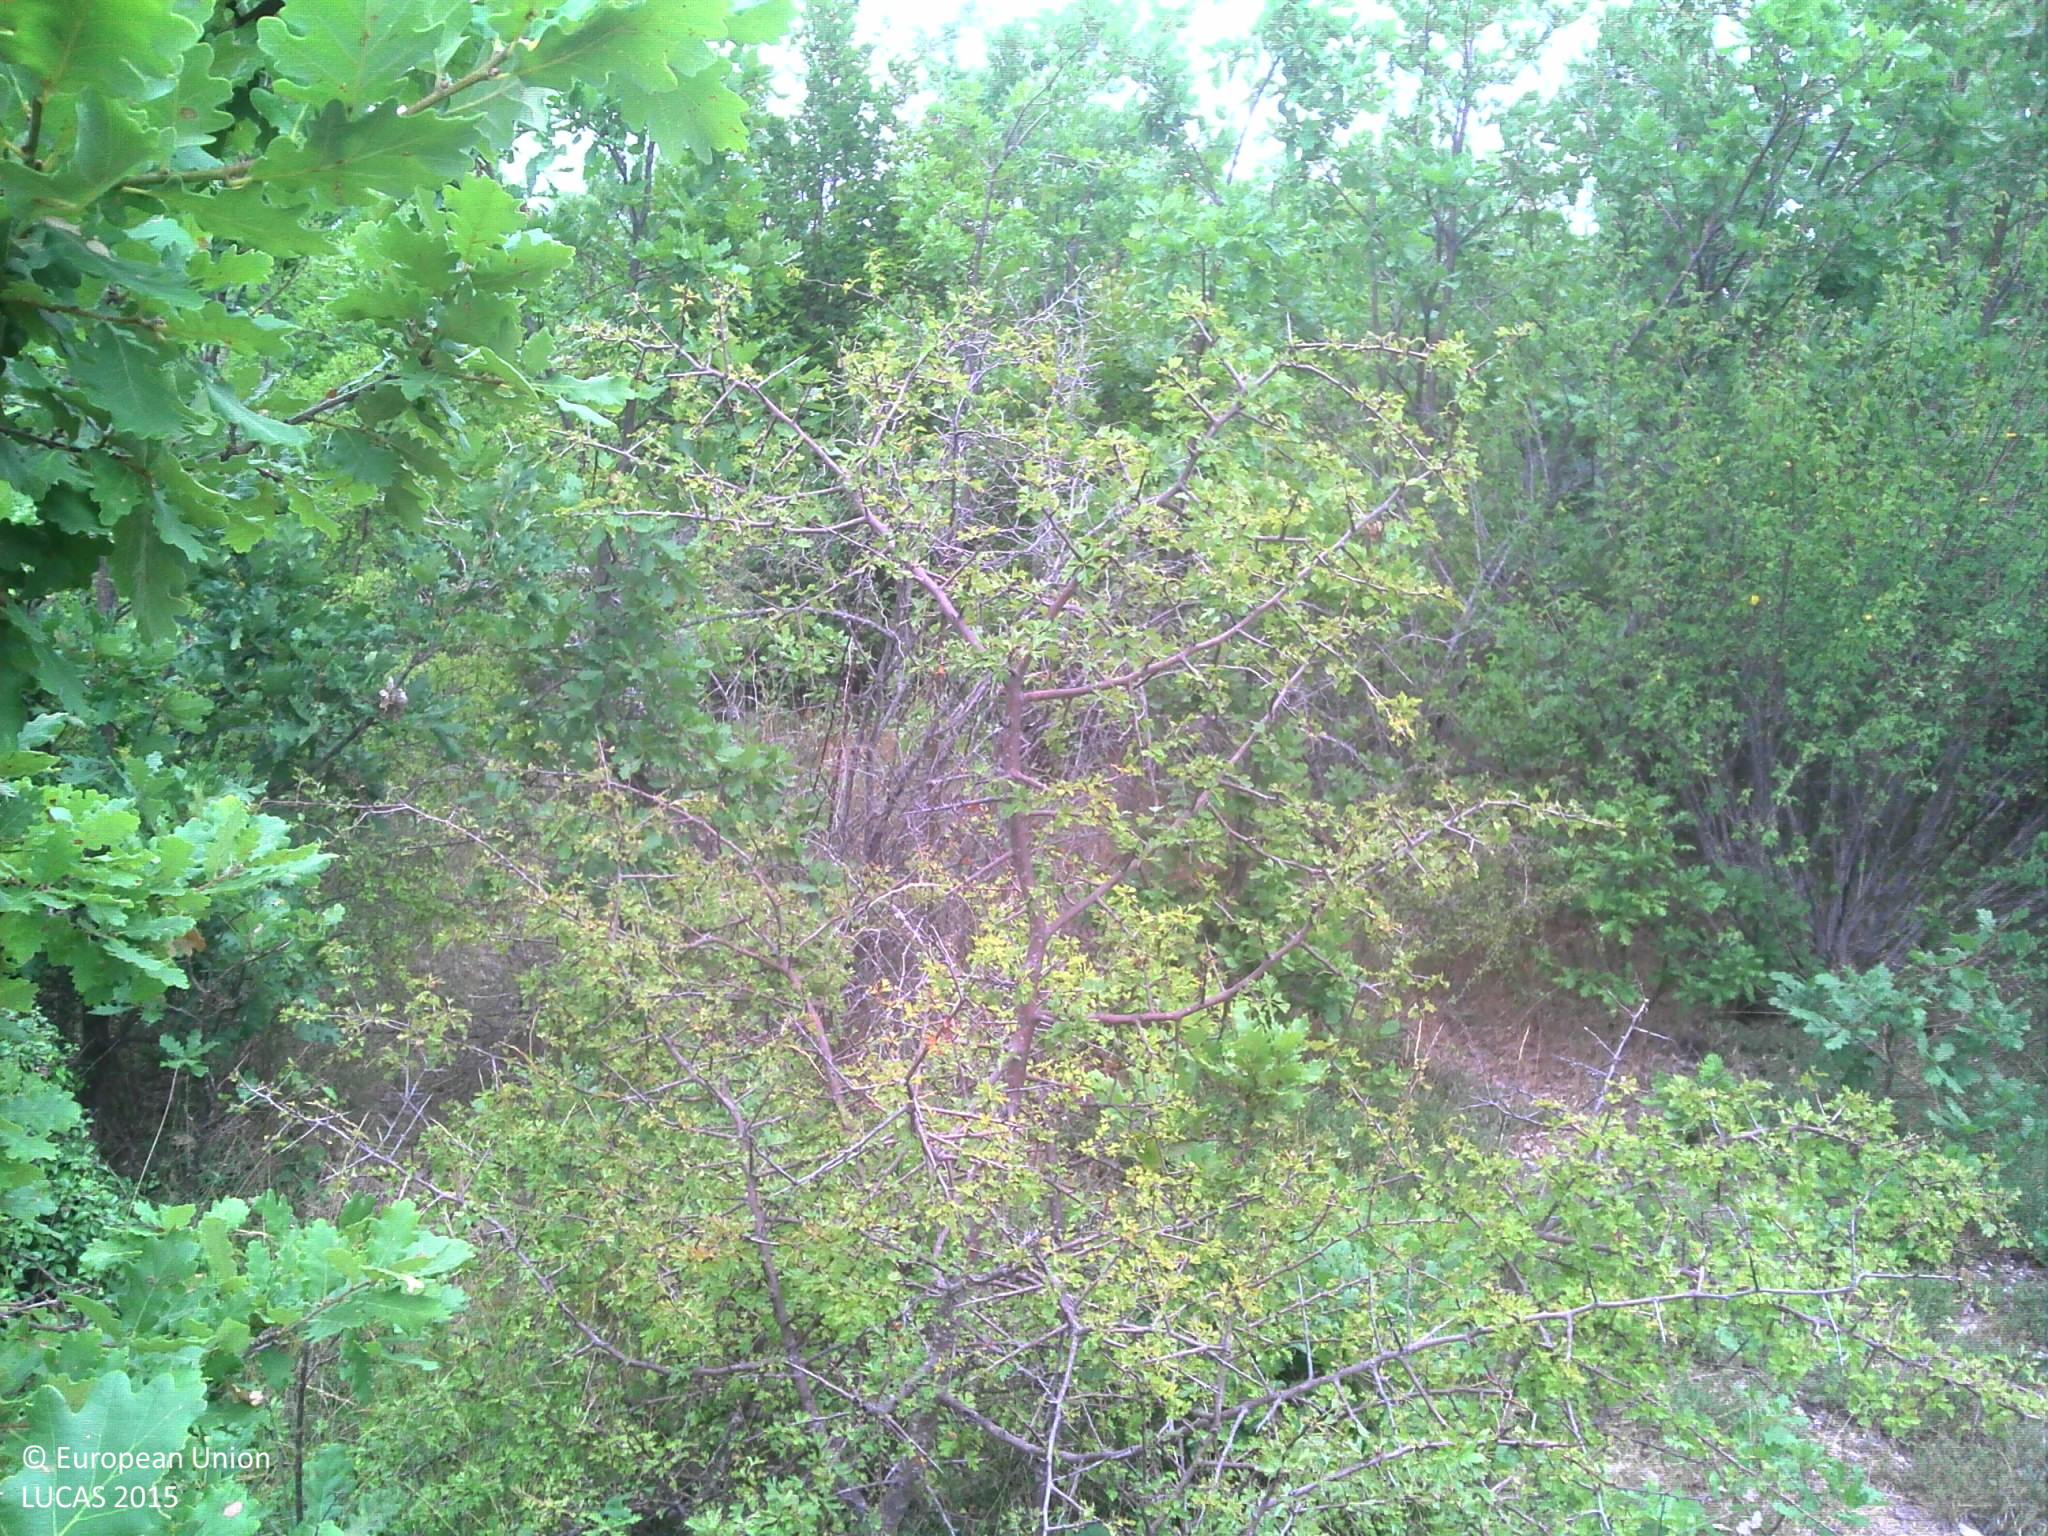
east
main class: Woodland
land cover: Broadleaved woodland
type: thermophilous deciduous forest
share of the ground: 50 - 75 %
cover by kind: broadleaved forest trees 65 %, shrubs 20 %, herbaceous plants 10 %, consolidated bare surface 5 %
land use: Forestry
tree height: > 5 m
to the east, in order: Broadleaved woodland; Tracks; Broadleaved woodland; Pine dominated mixed woodland
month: July
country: FR
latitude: 44.0576
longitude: 5.5767
